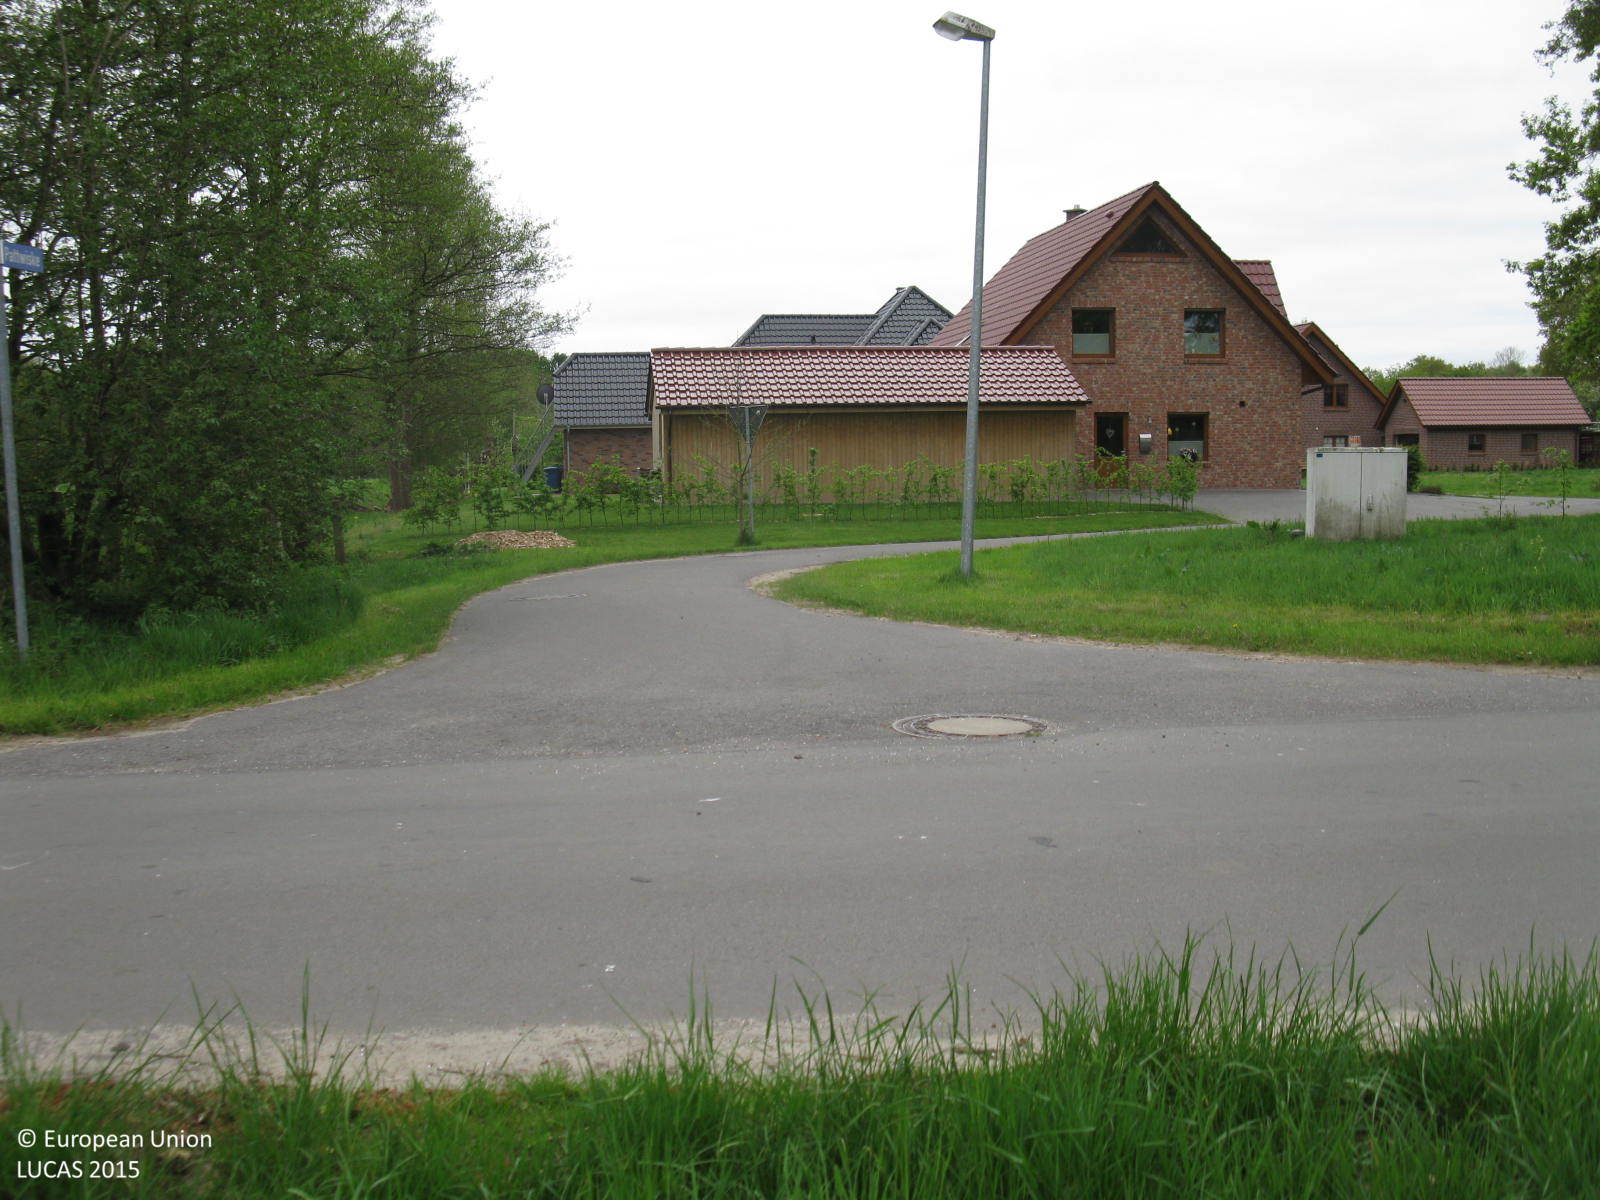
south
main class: Grassland
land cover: Grassland without tree/shrub cover
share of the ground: > 75 %
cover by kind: herbaceous plants 100 %
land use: Agriculture (excluding fallow land and kitchen gardens)
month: May
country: DE
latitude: 52.8872
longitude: 7.3402
